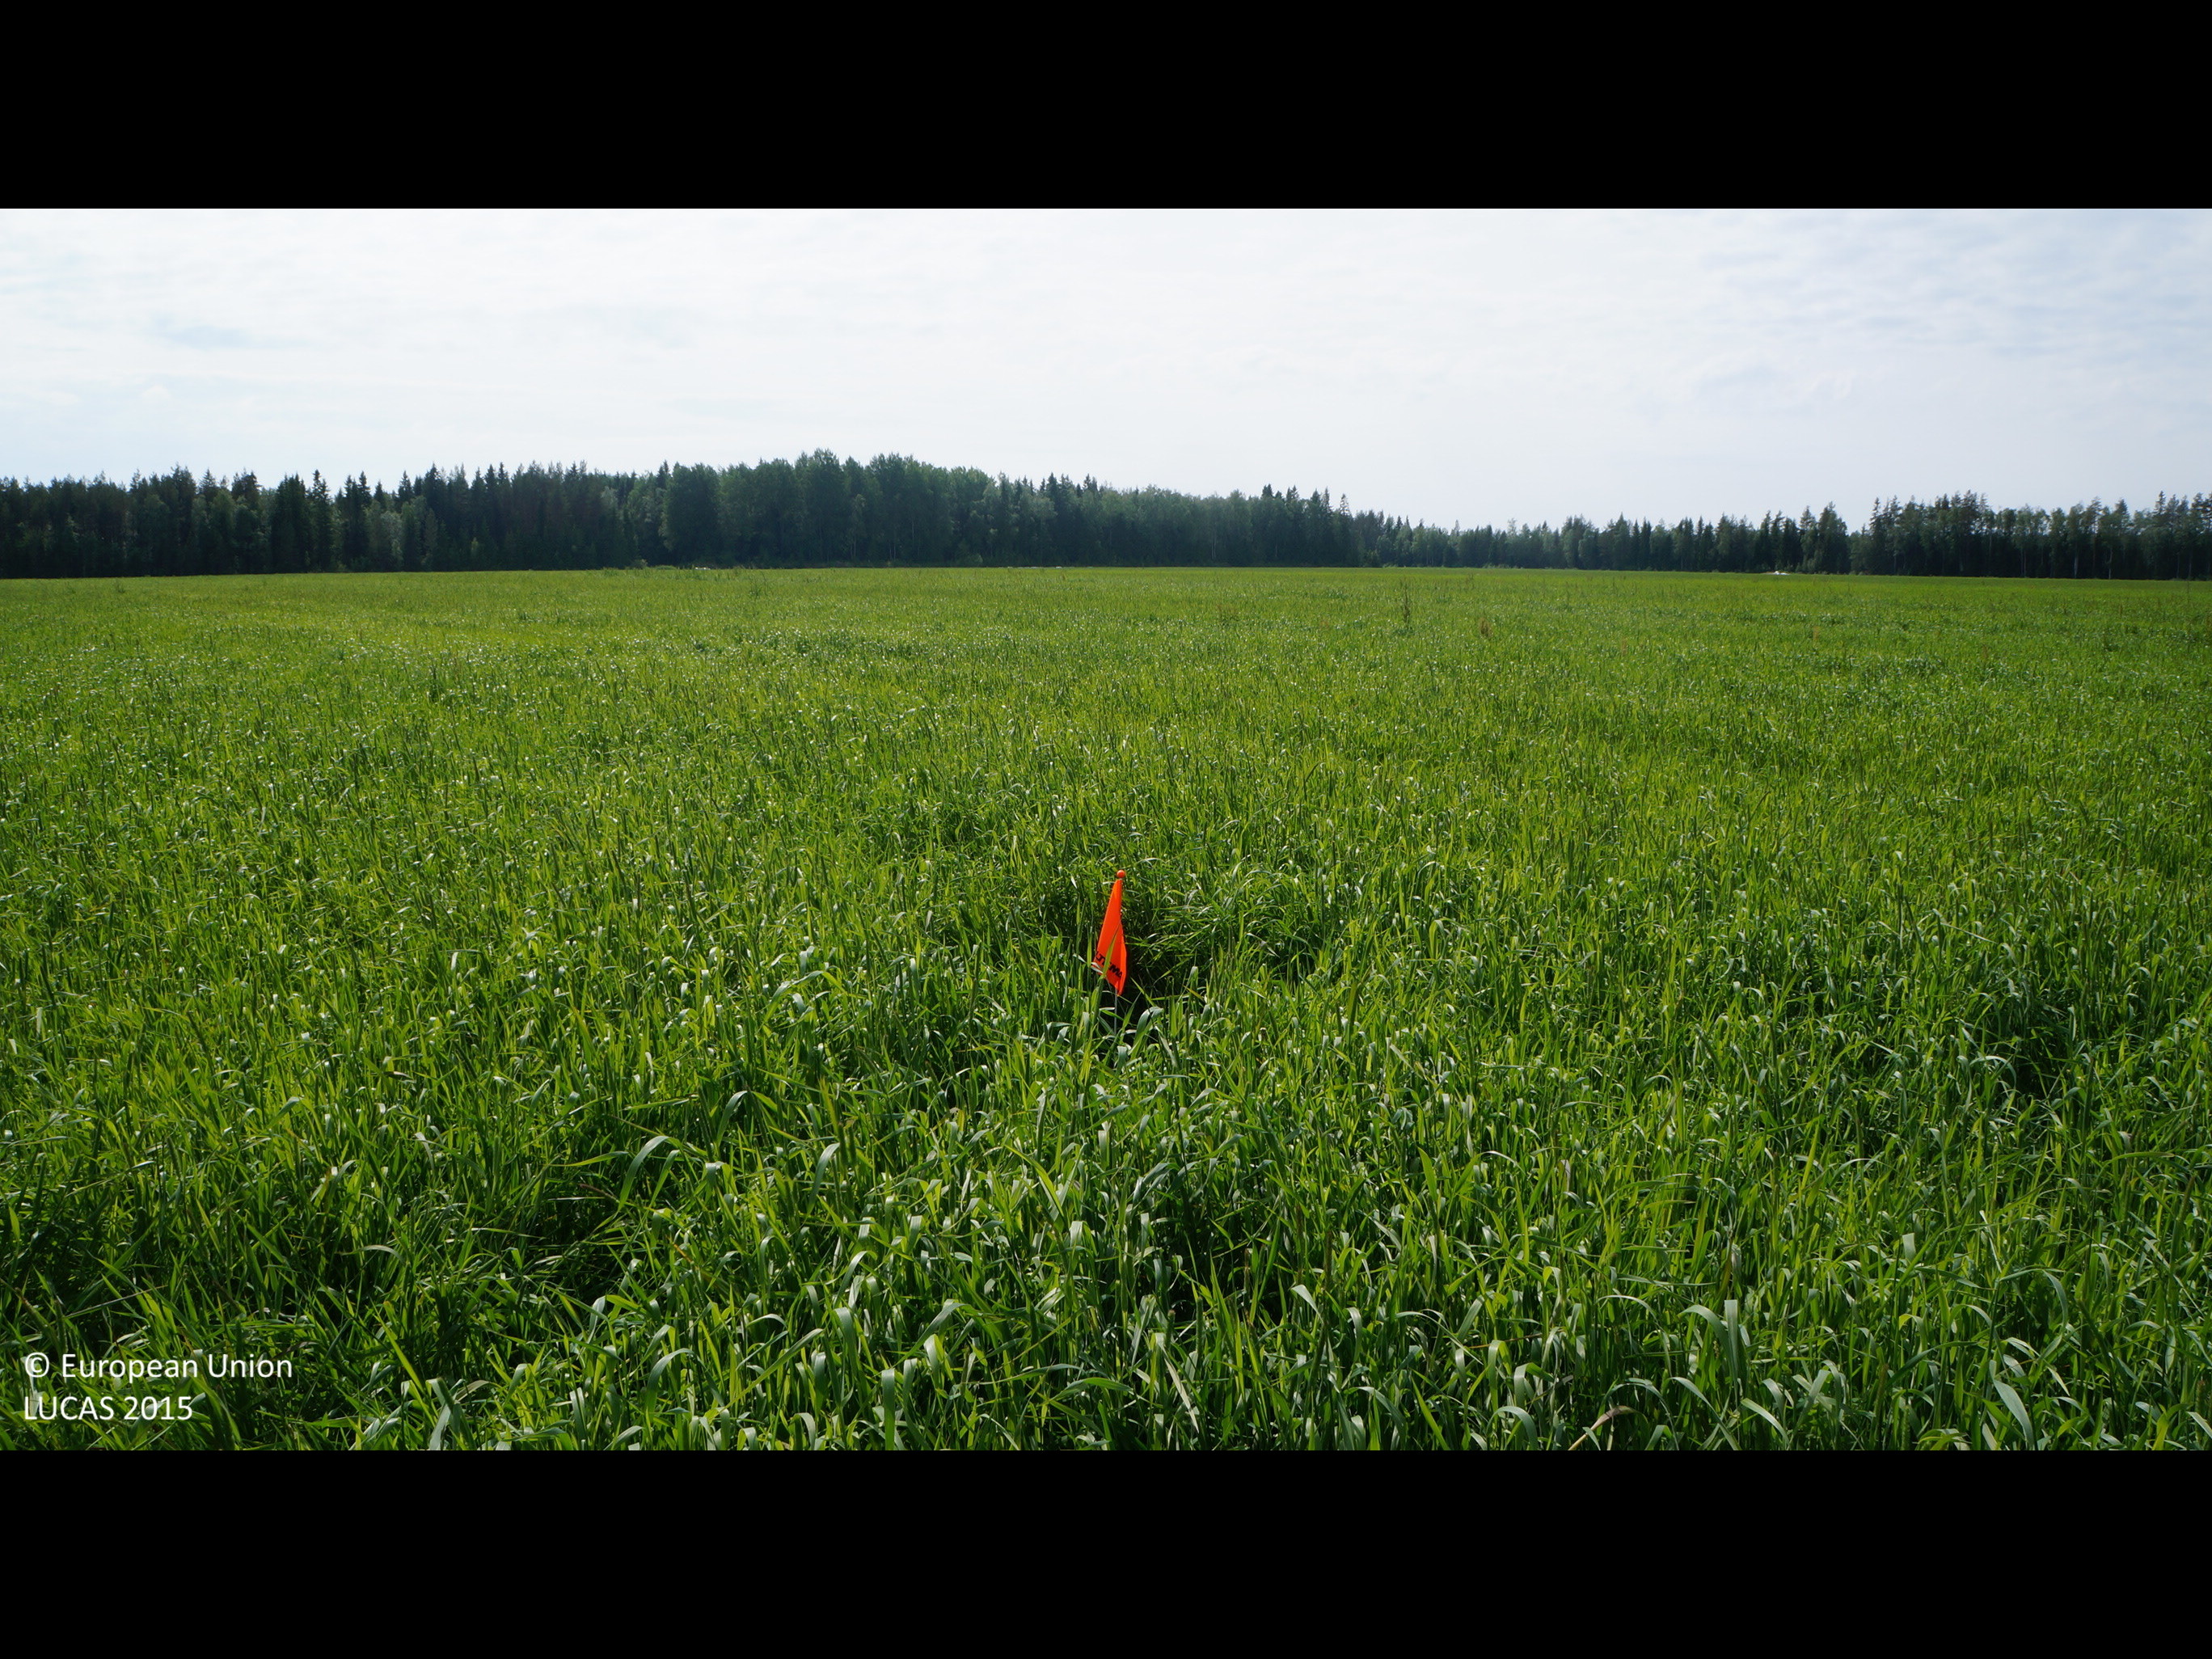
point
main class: Cropland
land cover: Temporary grasslands
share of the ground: > 75 %
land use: Agriculture (excluding fallow land and kitchen gardens)
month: June
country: FI
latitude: 64.1861
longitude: 23.9142
